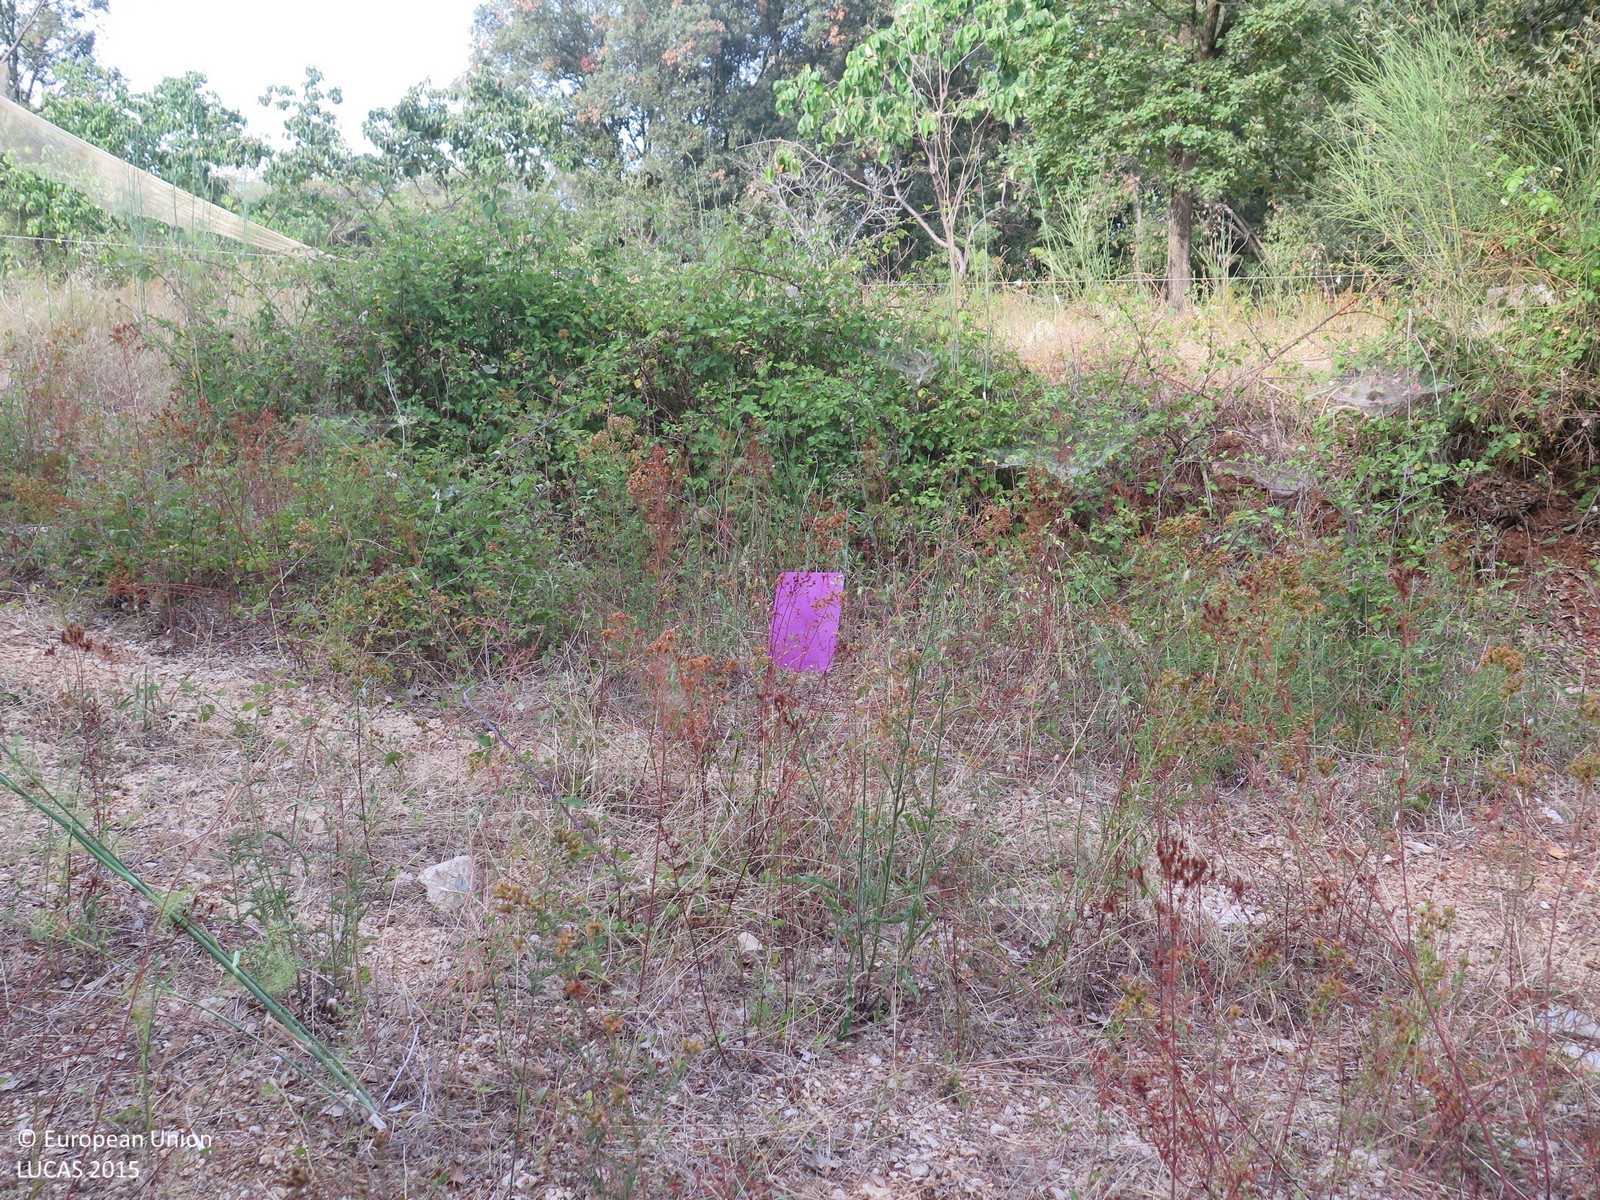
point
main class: Grassland
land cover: Grassland with sparse tree/shrub cover
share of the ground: 50 - 75 %
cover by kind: herbaceous plants 90 %, broadleaved forest trees 5 %, shrubs 5 %
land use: Agriculture (excluding fallow land and kitchen gardens)
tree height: > 5 m
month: July
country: HR
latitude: 45.0431
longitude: 13.6889
